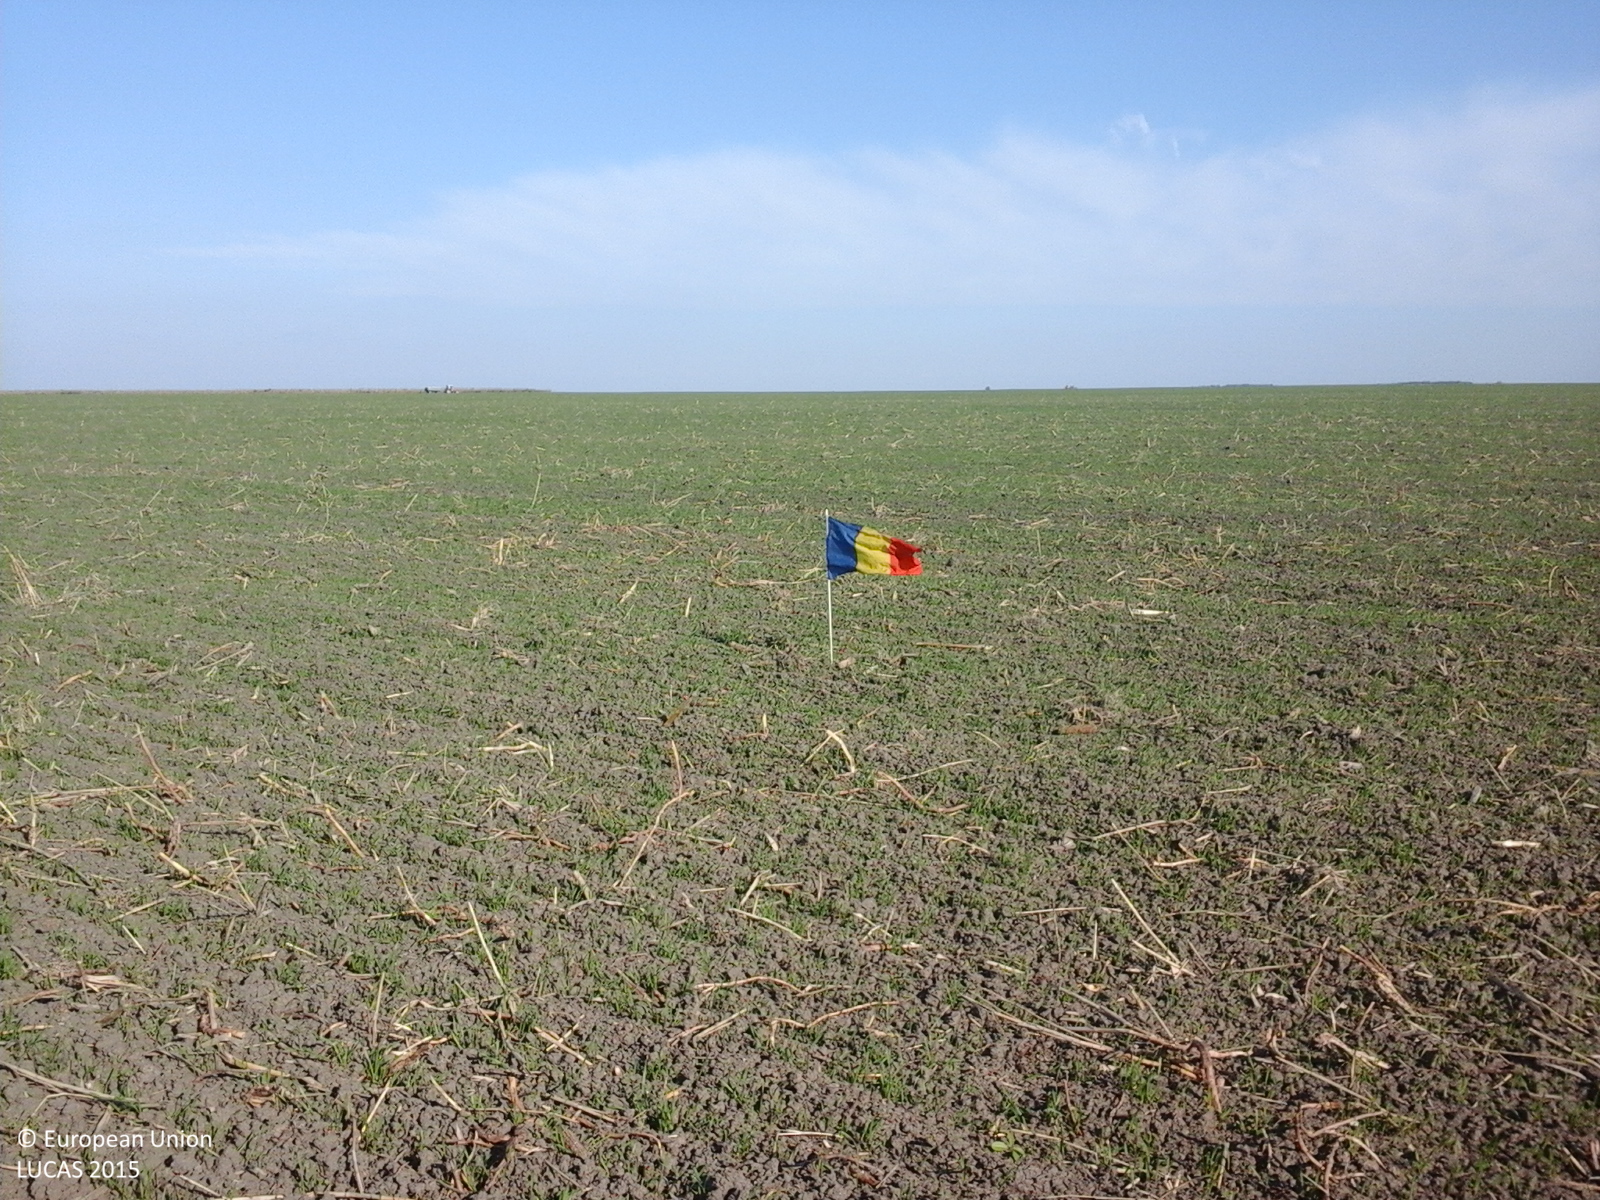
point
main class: Cropland
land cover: Common wheat
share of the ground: 25 - 50 %
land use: Agriculture (excluding fallow land and kitchen gardens)
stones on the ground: < 10 %
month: October
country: RO
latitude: 45.4145
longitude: 27.3610
